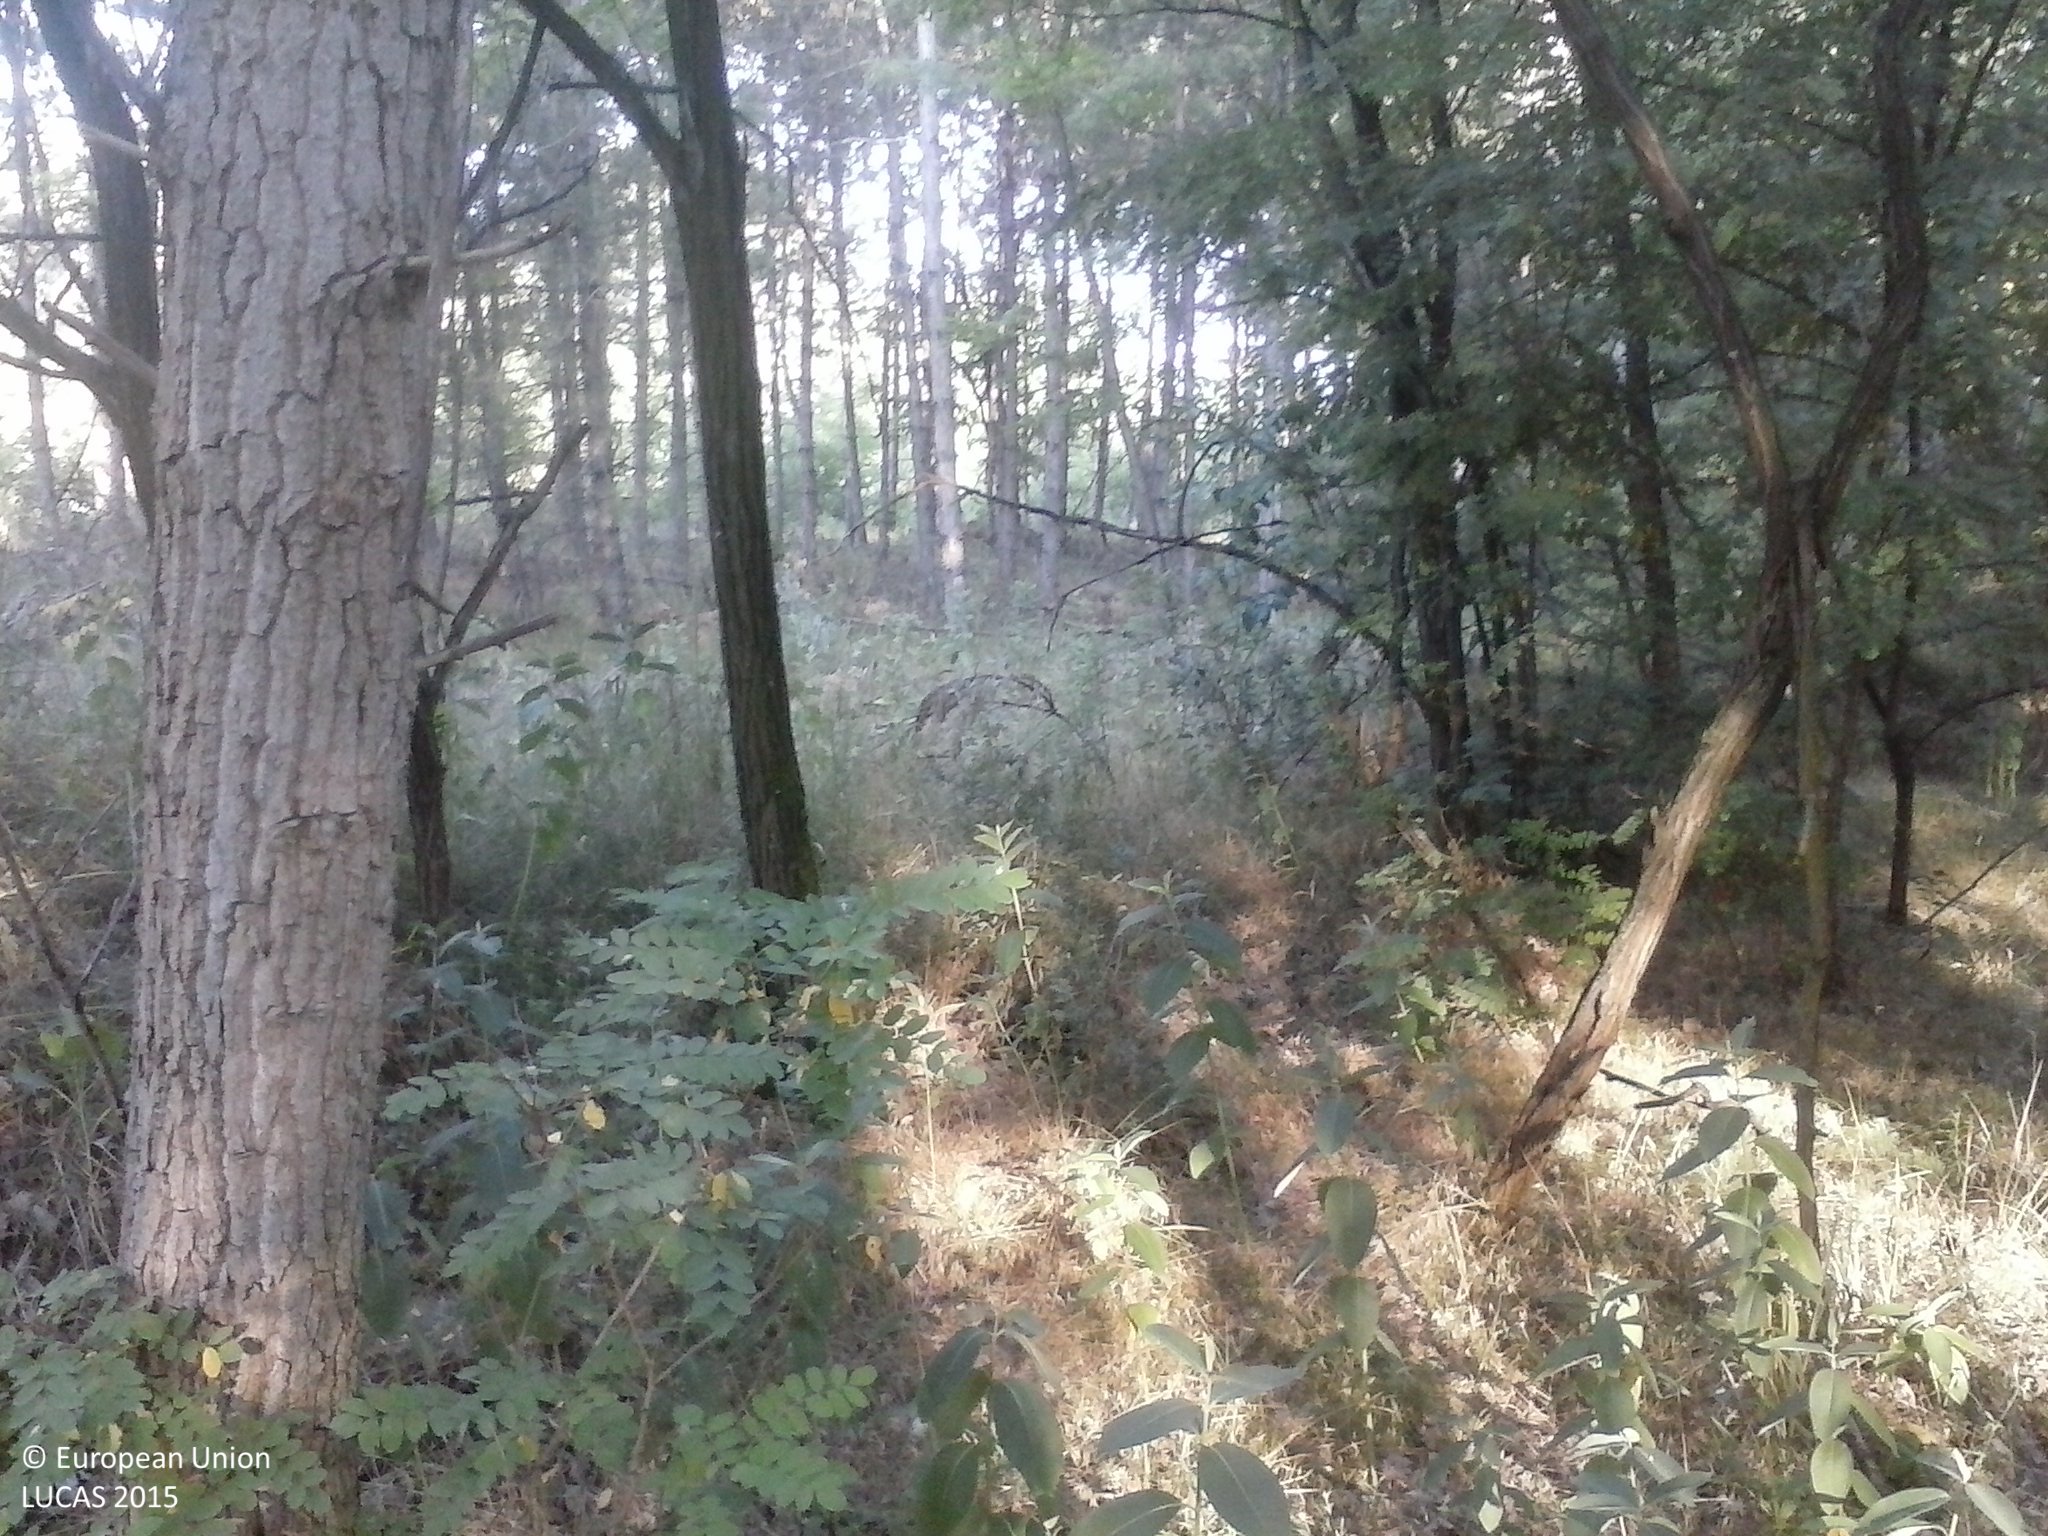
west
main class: Woodland
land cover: Pine dominated coniferous woodland
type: hemiboreal forest and nemoral coniferous forest and mixed broadleaved-coniferous forest
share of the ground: > 75 %
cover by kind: coniferous forest trees 80 %, broadleaved forest trees 10 %, shrubs 5 %, herbaceous plants 5 %
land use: Forestry
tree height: > 5 m
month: July
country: HU
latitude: 46.4053
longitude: 19.6308
